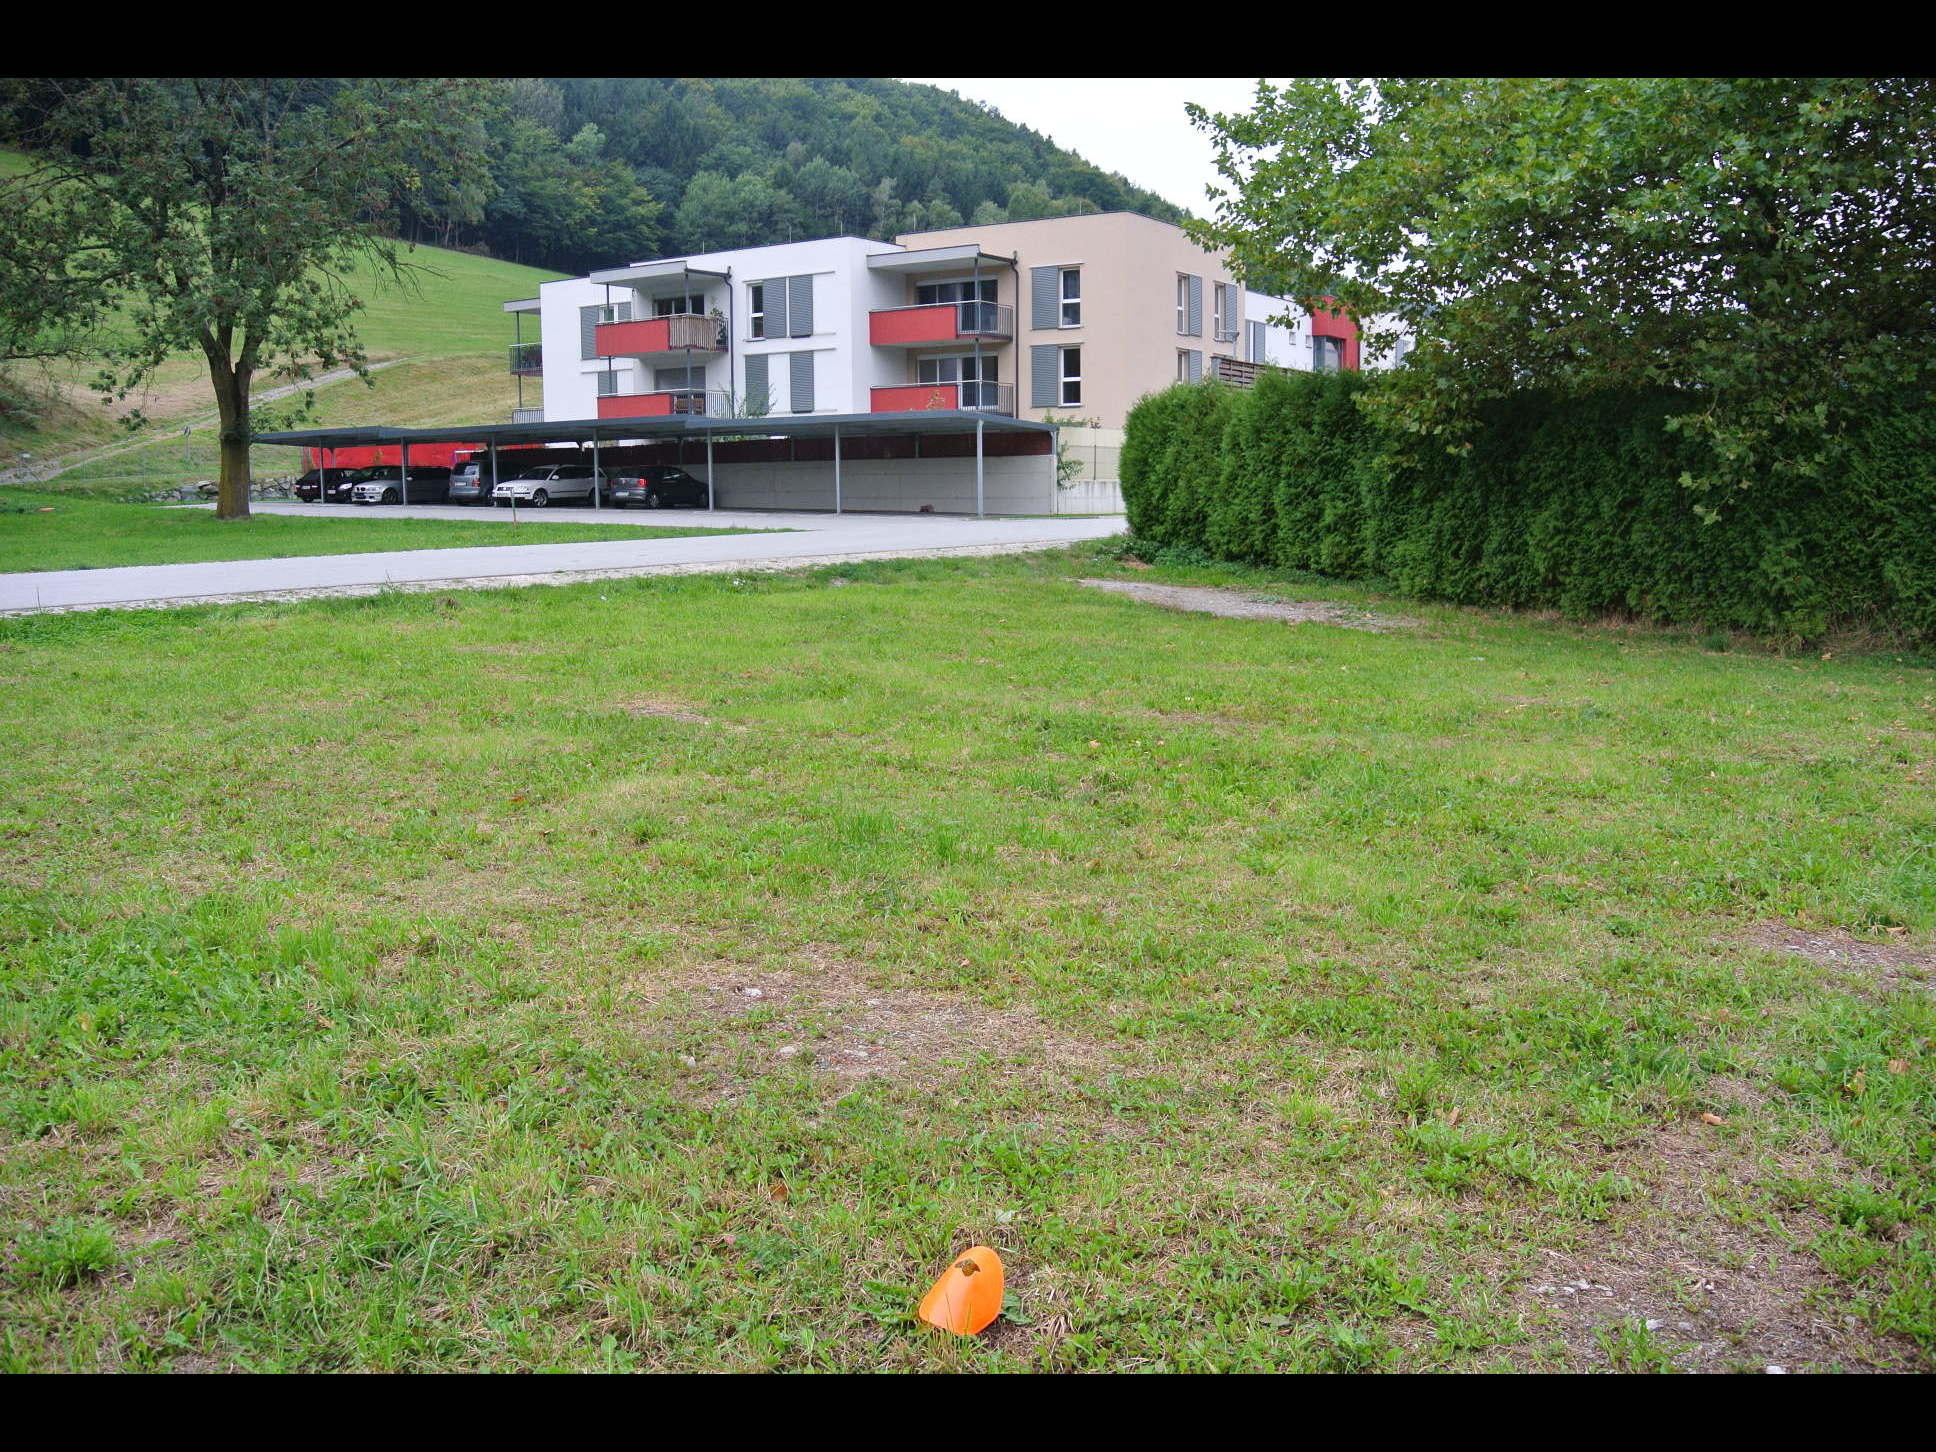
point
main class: Grassland
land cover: Grassland without tree/shrub cover
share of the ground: > 75 %
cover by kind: herbaceous plants 100 %
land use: Abandoned areas
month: July
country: AT
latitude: 47.6015
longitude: 16.1345
